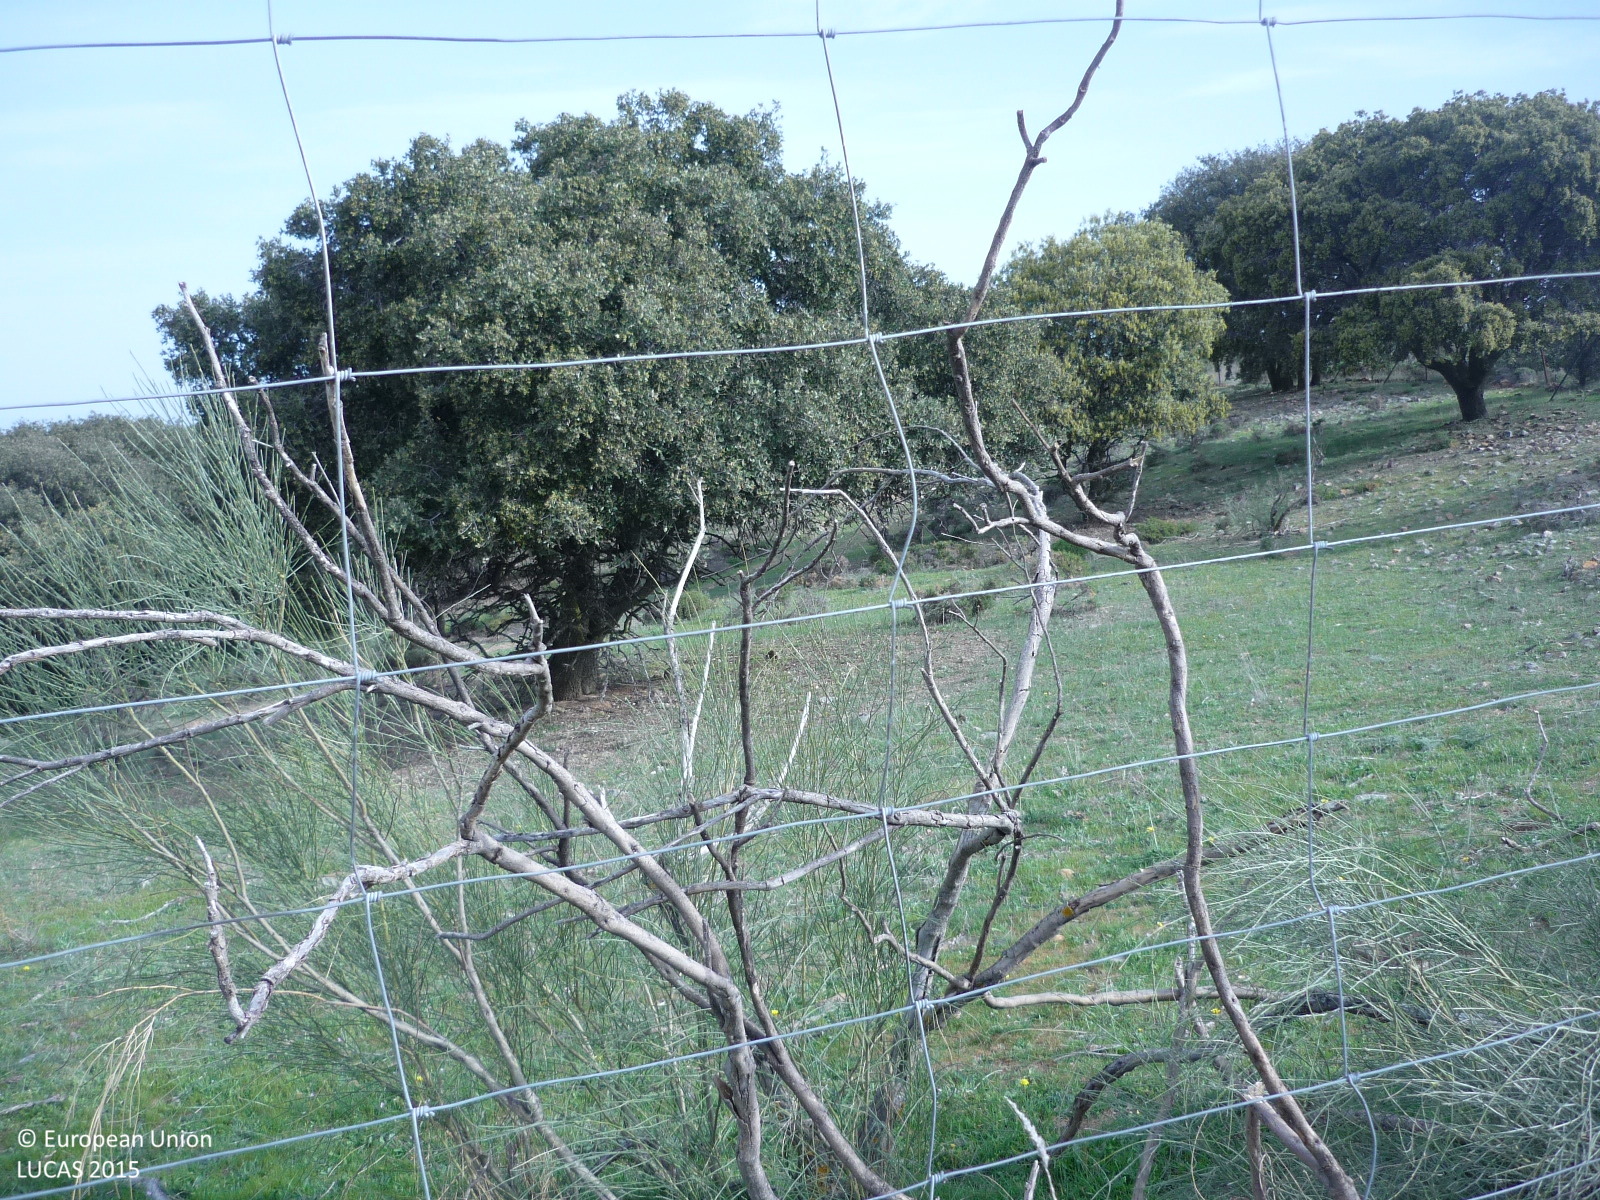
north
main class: Woodland
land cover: Broadleaved woodland
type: broadleaved evergreen forest
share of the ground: 50 - 75 %
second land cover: Grassland without tree/shrub cover
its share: > 75 %
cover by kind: broadleaved forest trees 60 %, herbaceous plants 25 %, unconsolidated bare surface 10 %, shrubs 5 %
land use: Forestry
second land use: Agriculture (excluding fallow land and kitchen gardens)
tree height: < 5 m
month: April
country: ES
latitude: 40.6597
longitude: -3.4142
